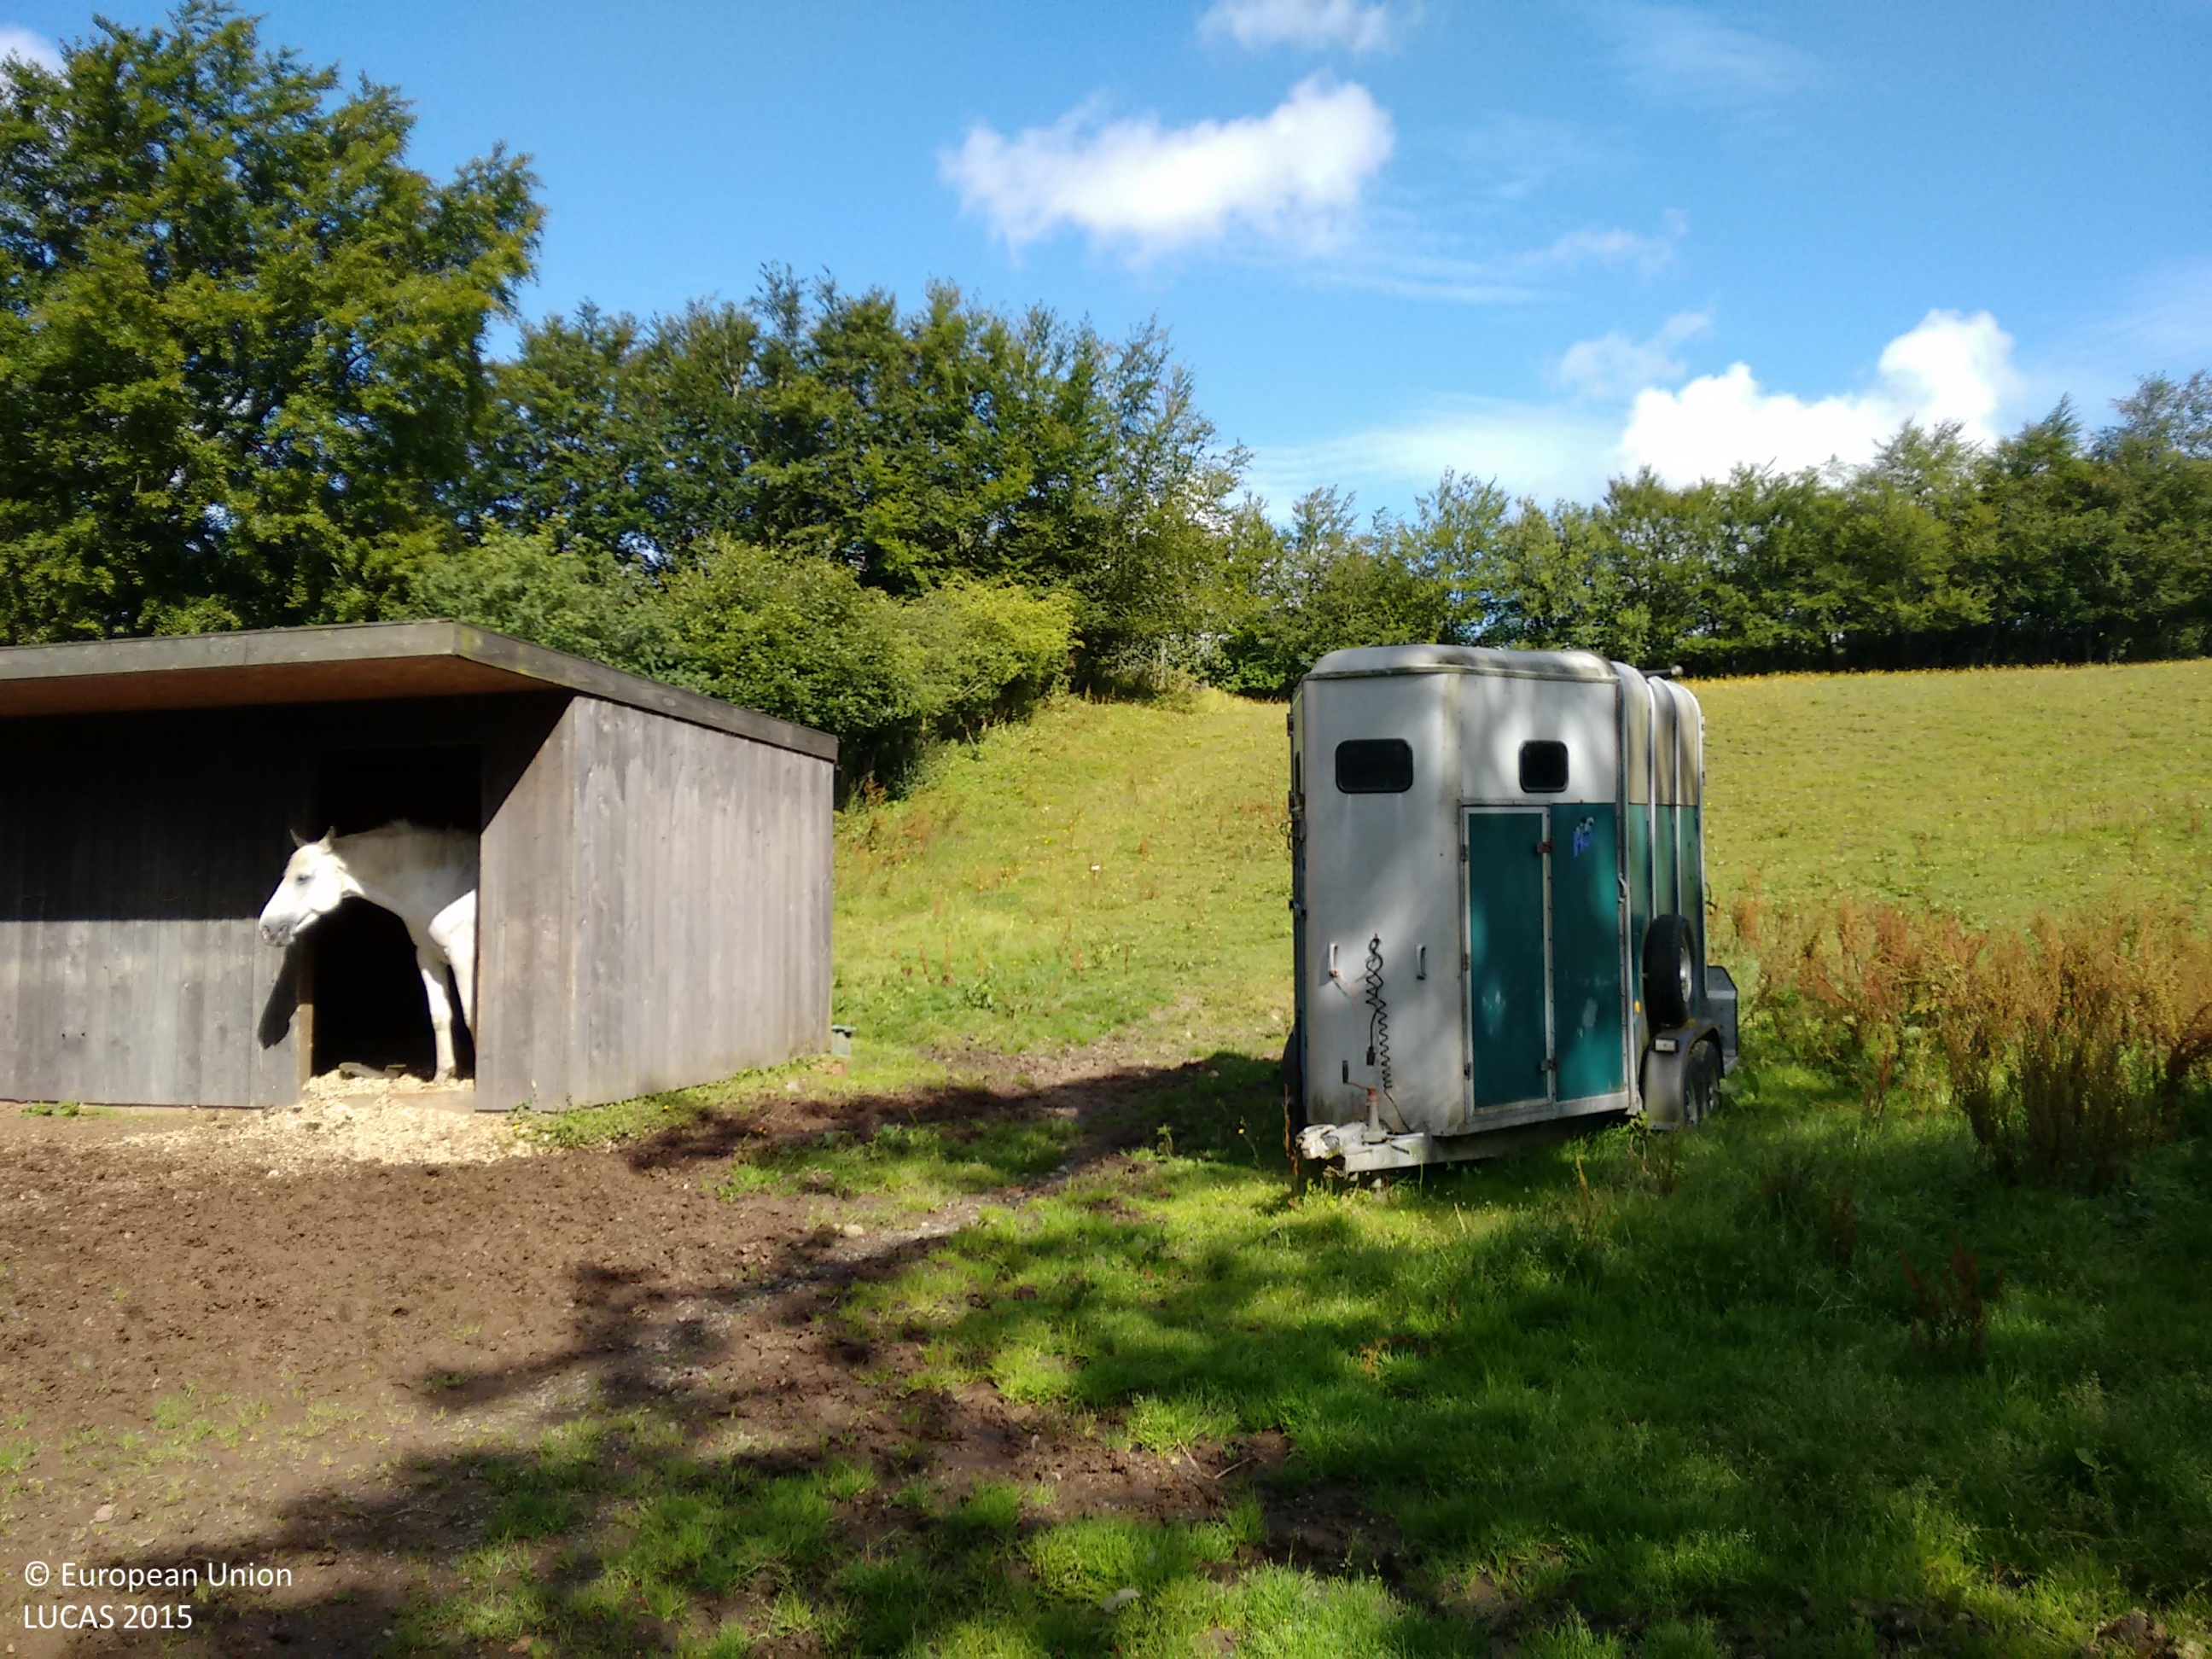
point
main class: Grassland
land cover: Grassland without tree/shrub cover
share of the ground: > 75 %
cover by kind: herbaceous plants 95 %, unconsolidated bare surface 5 %
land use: Agriculture (excluding fallow land and kitchen gardens)
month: August
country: GB
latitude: 55.9374
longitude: -3.7376
